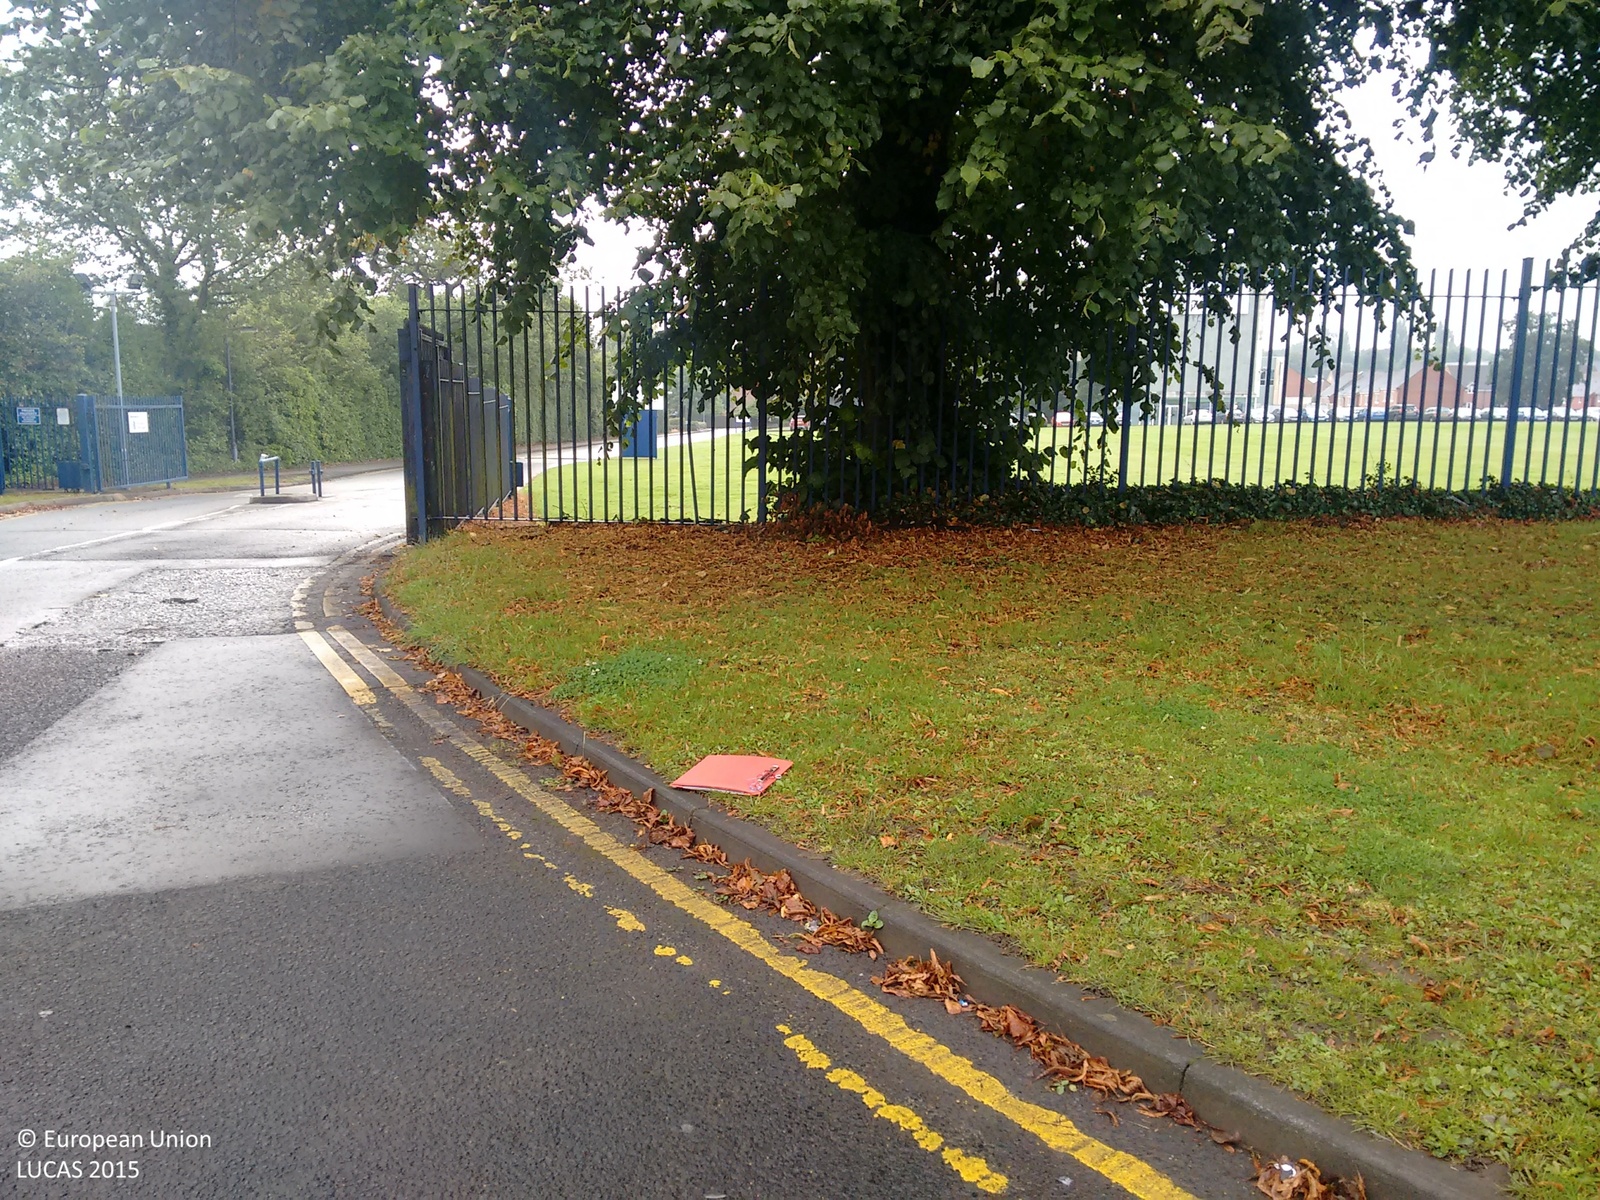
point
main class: Grassland
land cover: Grassland with sparse tree/shrub cover
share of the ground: > 75 %
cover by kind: herbaceous plants 65 %, consolidated bare surface 30 %, broadleaved forest trees 5 %
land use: Amenities, museums, leisure
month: September
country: GB
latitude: 52.4047
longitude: -1.9789
